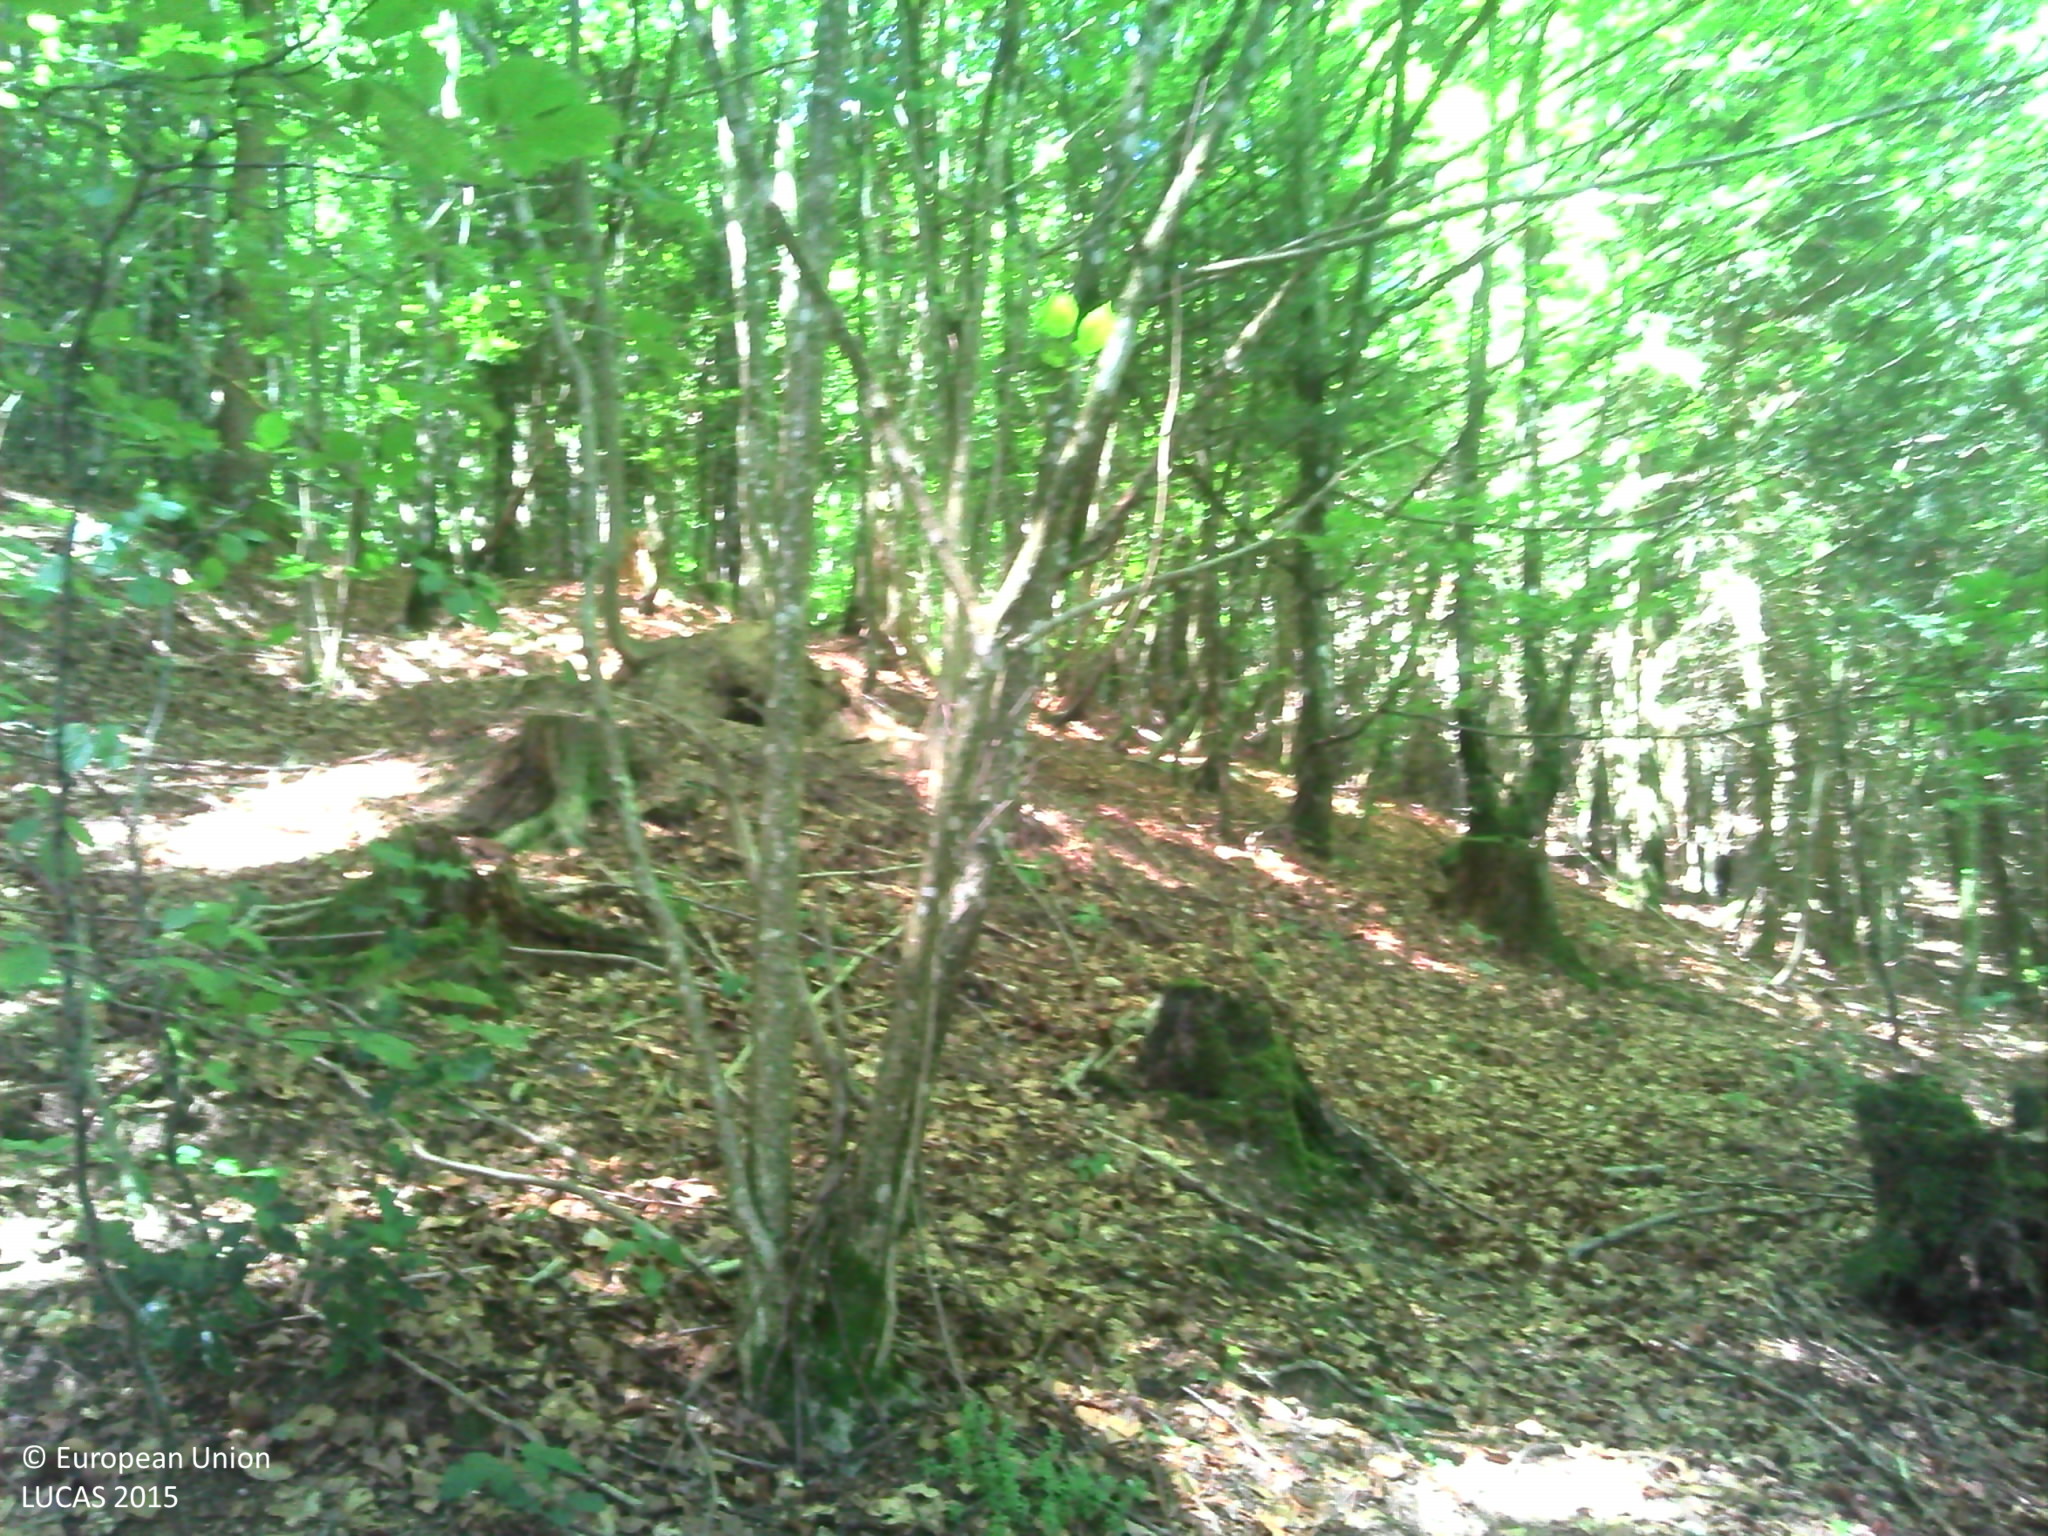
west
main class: Woodland
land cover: Spruce dominated mixed woodland
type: mountainous beech forest
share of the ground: > 75 %
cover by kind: coniferous forest trees 40 %, broadleaved forest trees 35 %, herbaceous plants 15 %, lichens and mosses 10 %
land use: Forestry
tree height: > 5 m
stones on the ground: < 10 %
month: July
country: FR
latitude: 46.2361
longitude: 6.3854
